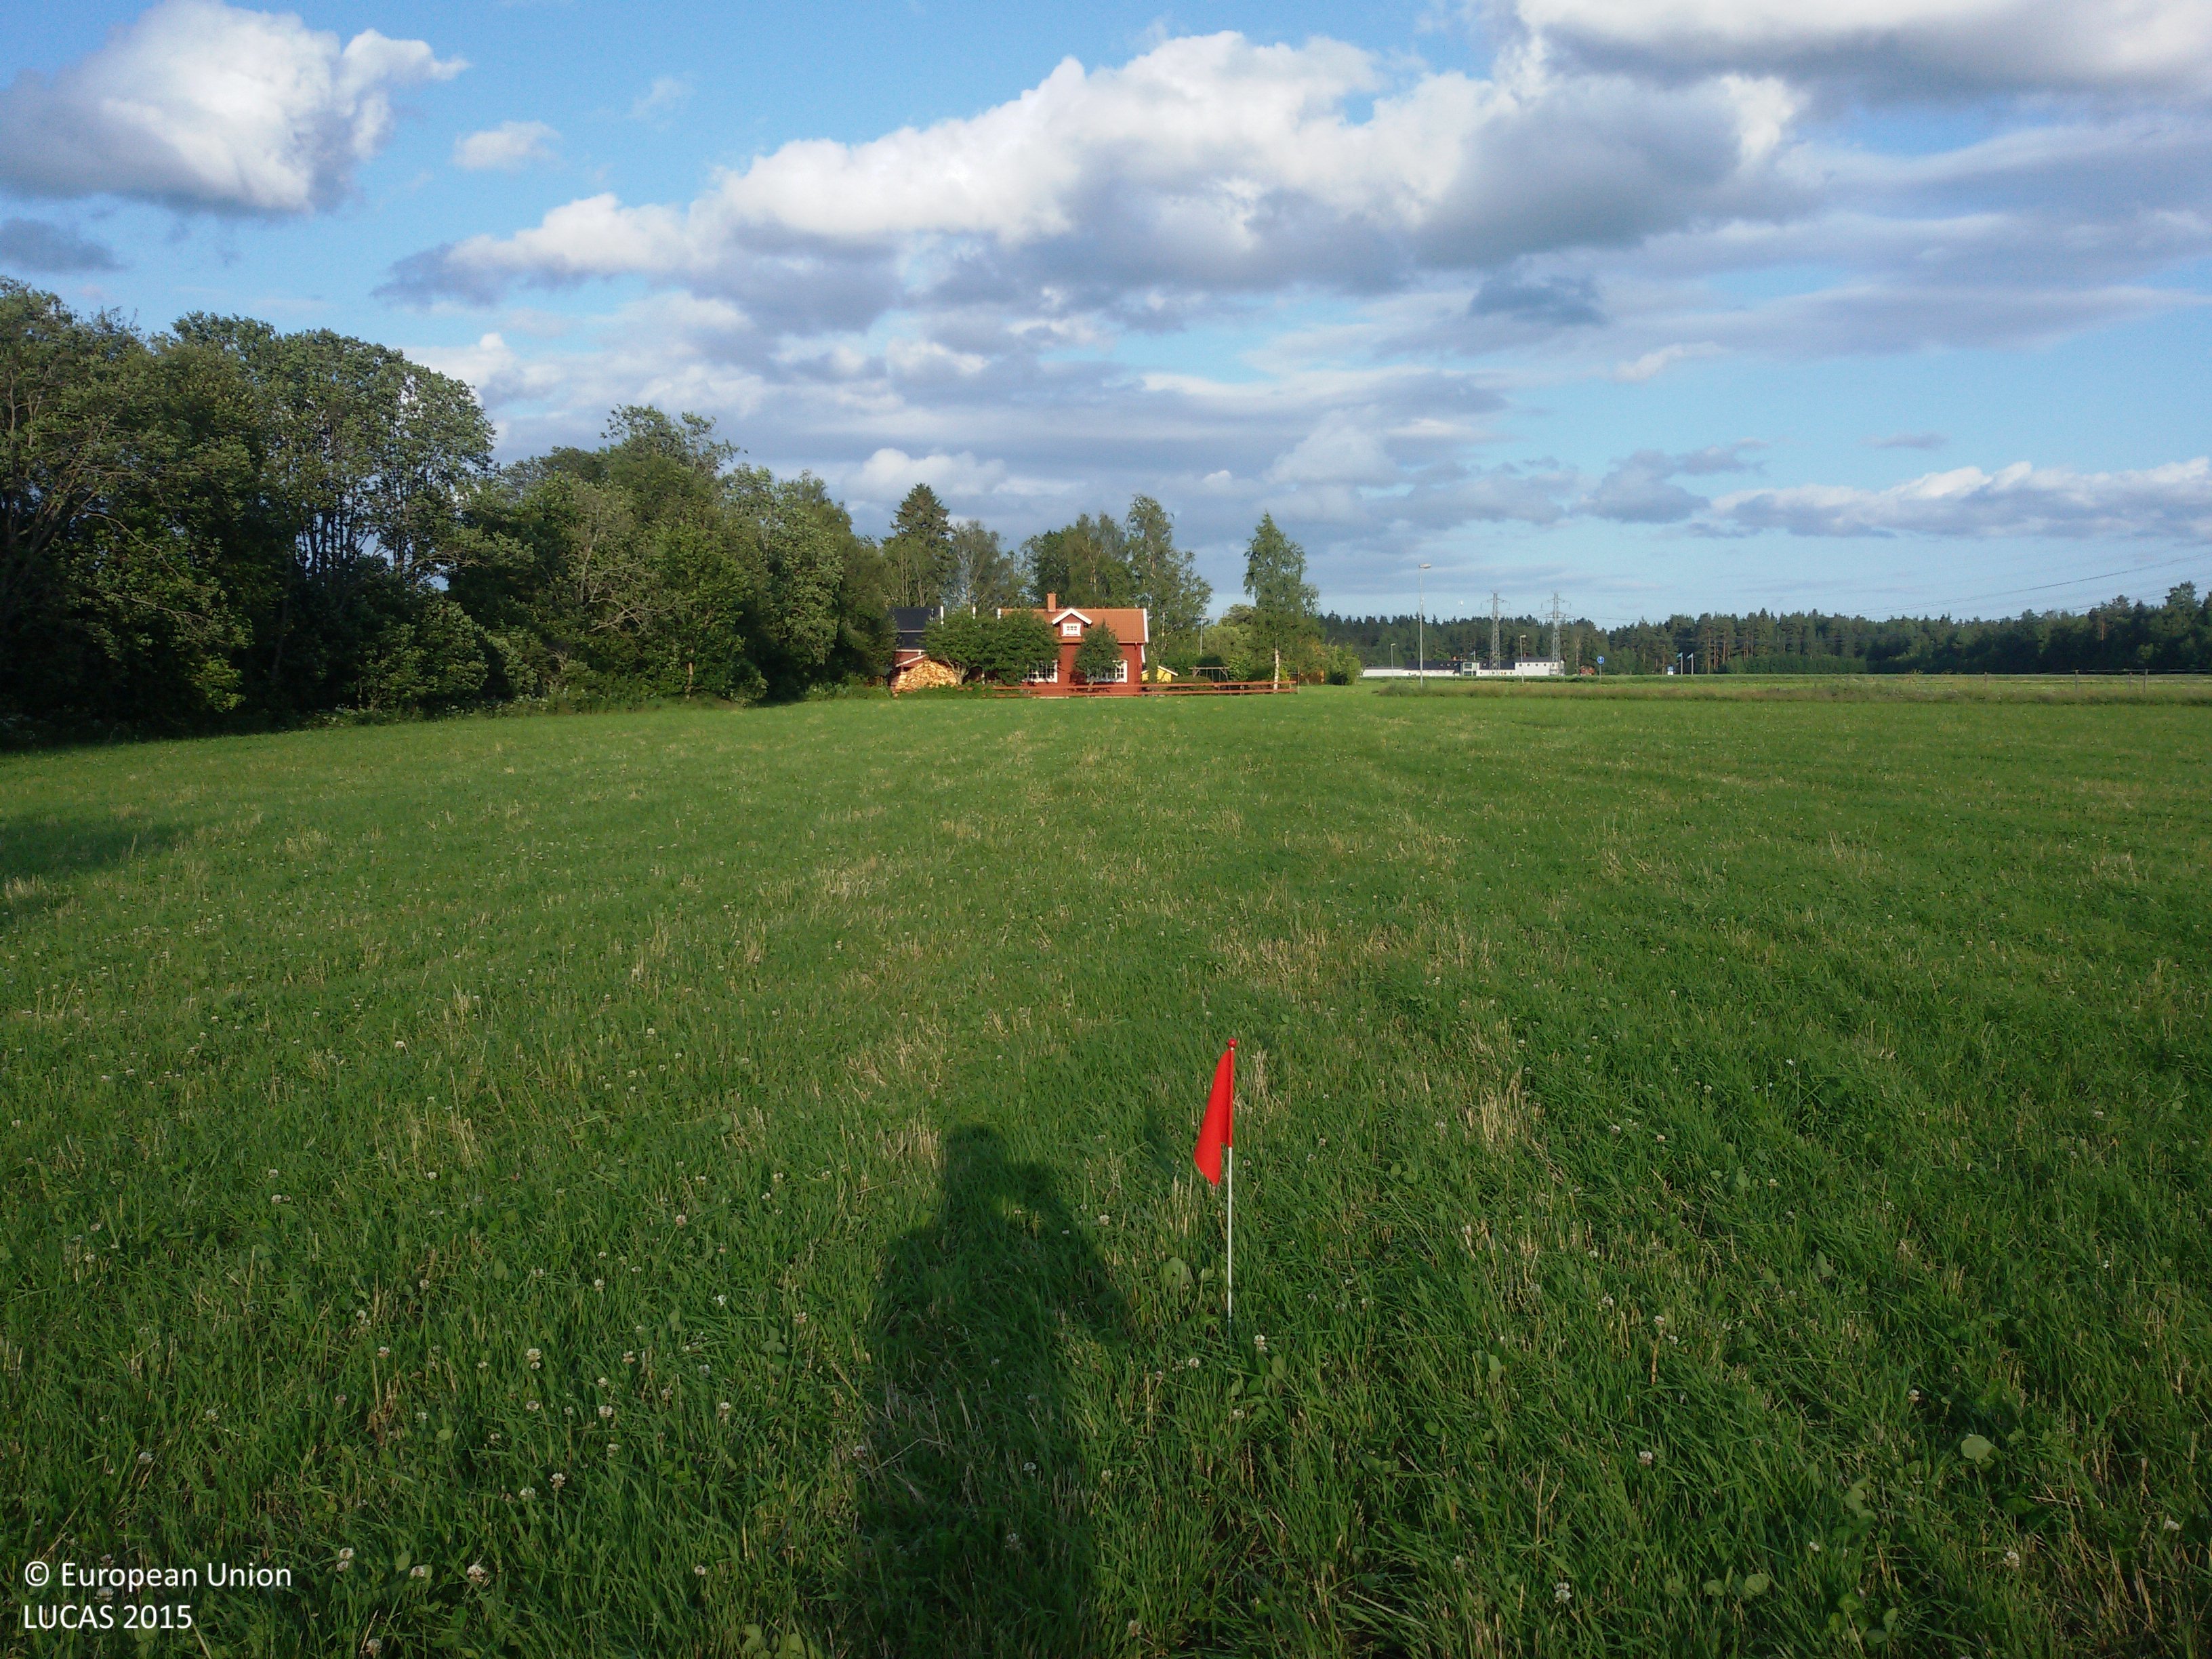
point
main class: Grassland
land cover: Grassland without tree/shrub cover
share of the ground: > 75 %
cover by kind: herbaceous plants 100 %
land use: Agriculture (excluding fallow land and kitchen gardens)
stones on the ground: < 10 %
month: July
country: SE
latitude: 60.5120
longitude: 15.3603
